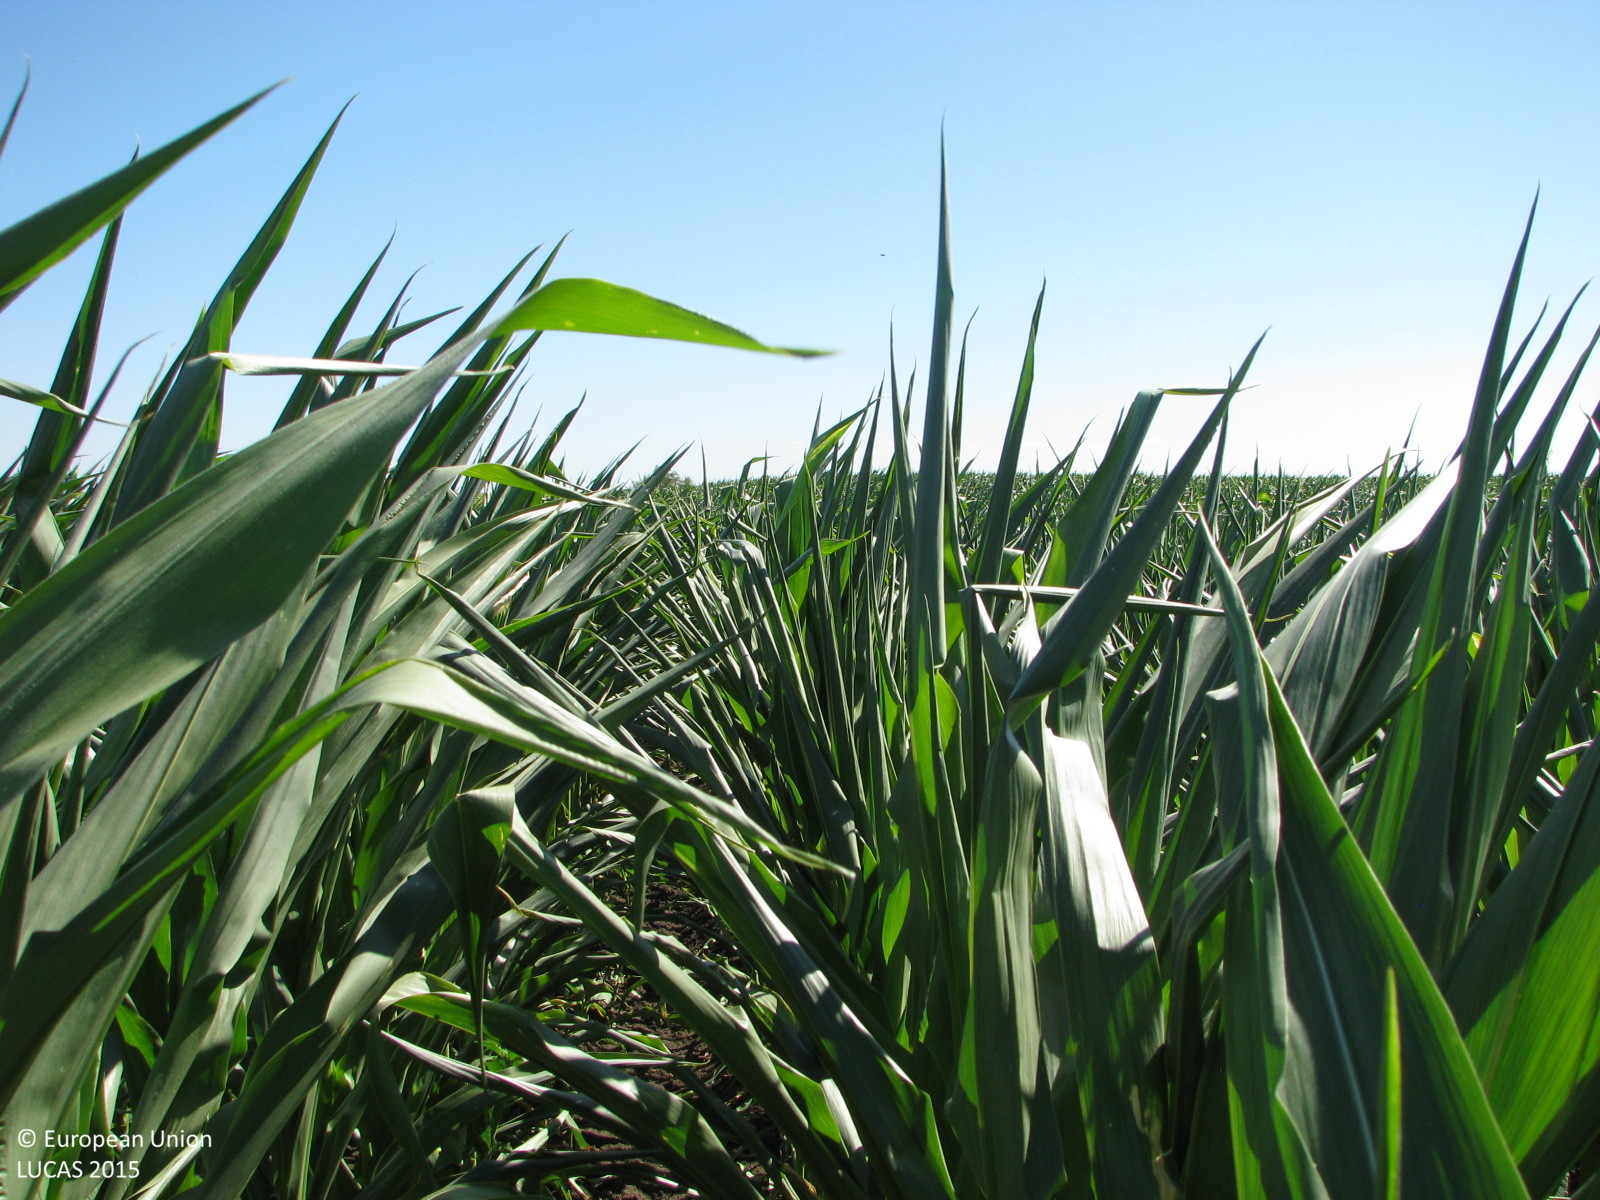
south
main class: Cropland
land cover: Maize
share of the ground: > 75 %
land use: Agriculture (excluding fallow land and kitchen gardens)
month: July
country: BG
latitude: 42.3650
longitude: 25.9978
